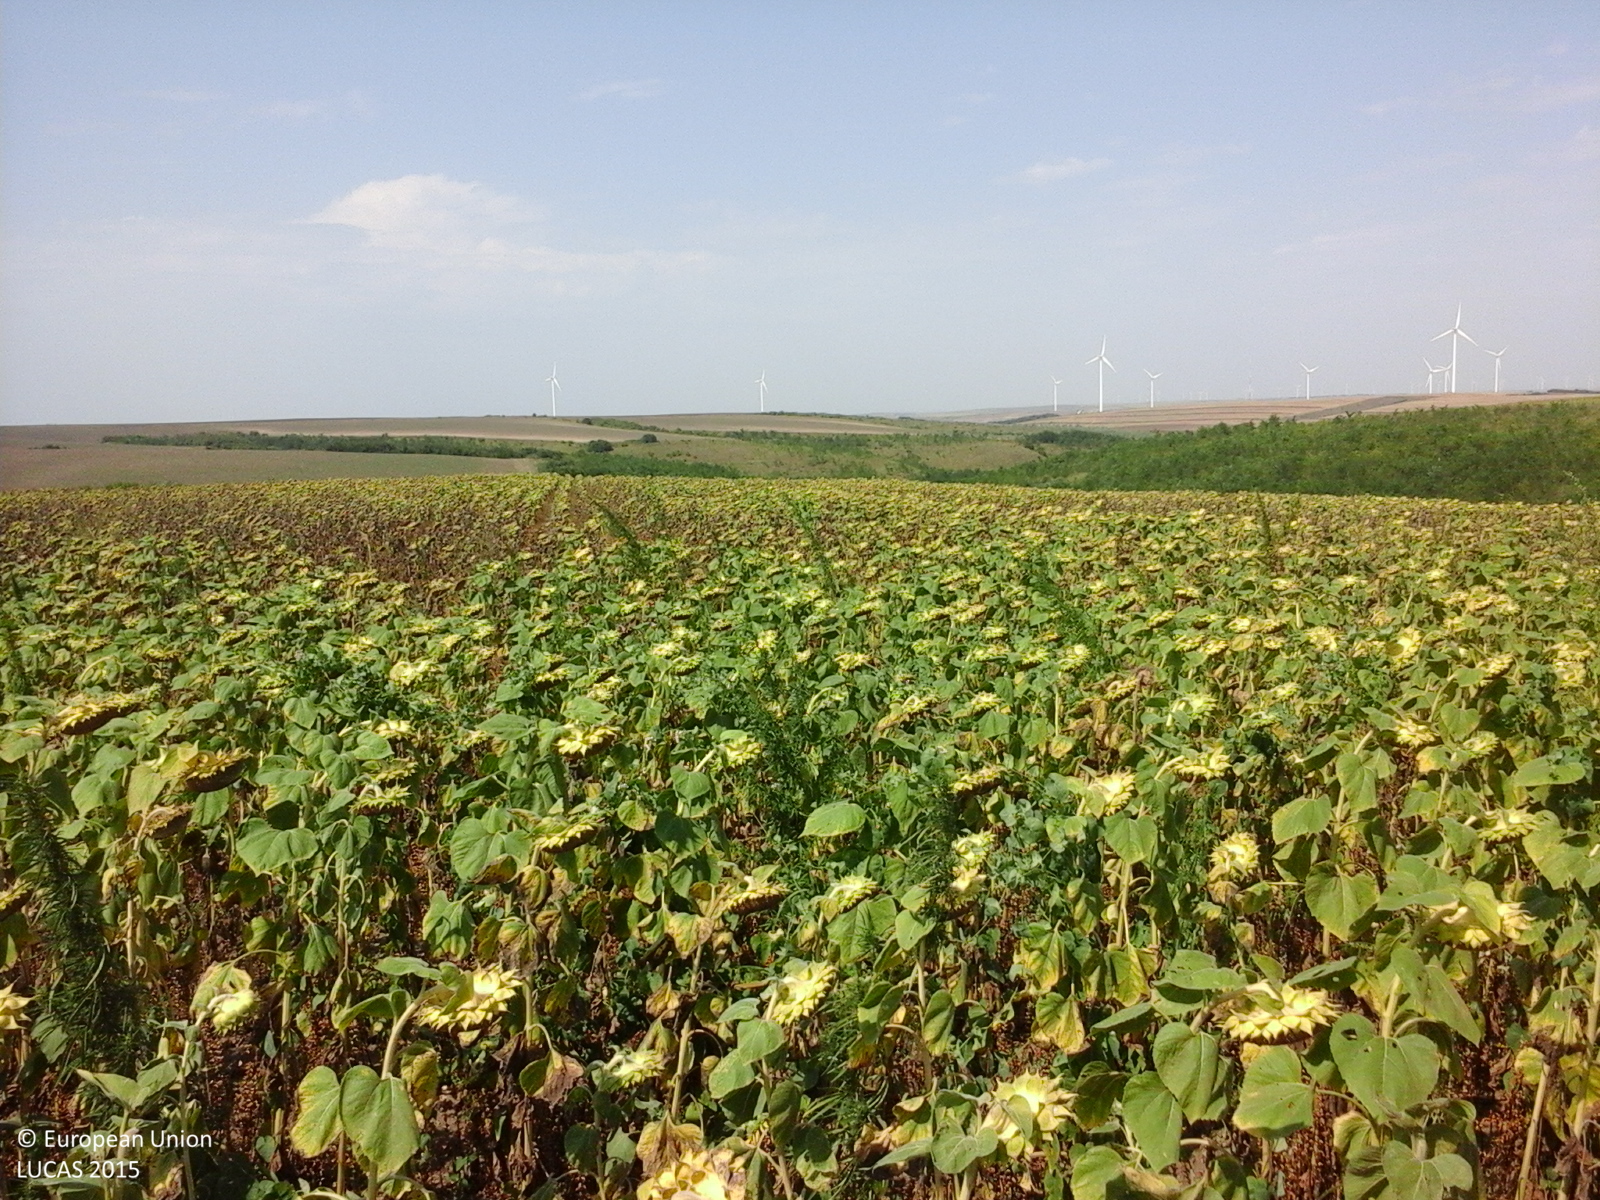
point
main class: Cropland
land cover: Sunflower
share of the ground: > 75 %
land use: Agriculture (excluding fallow land and kitchen gardens)
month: August
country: RO
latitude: 44.1800
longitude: 28.0042
